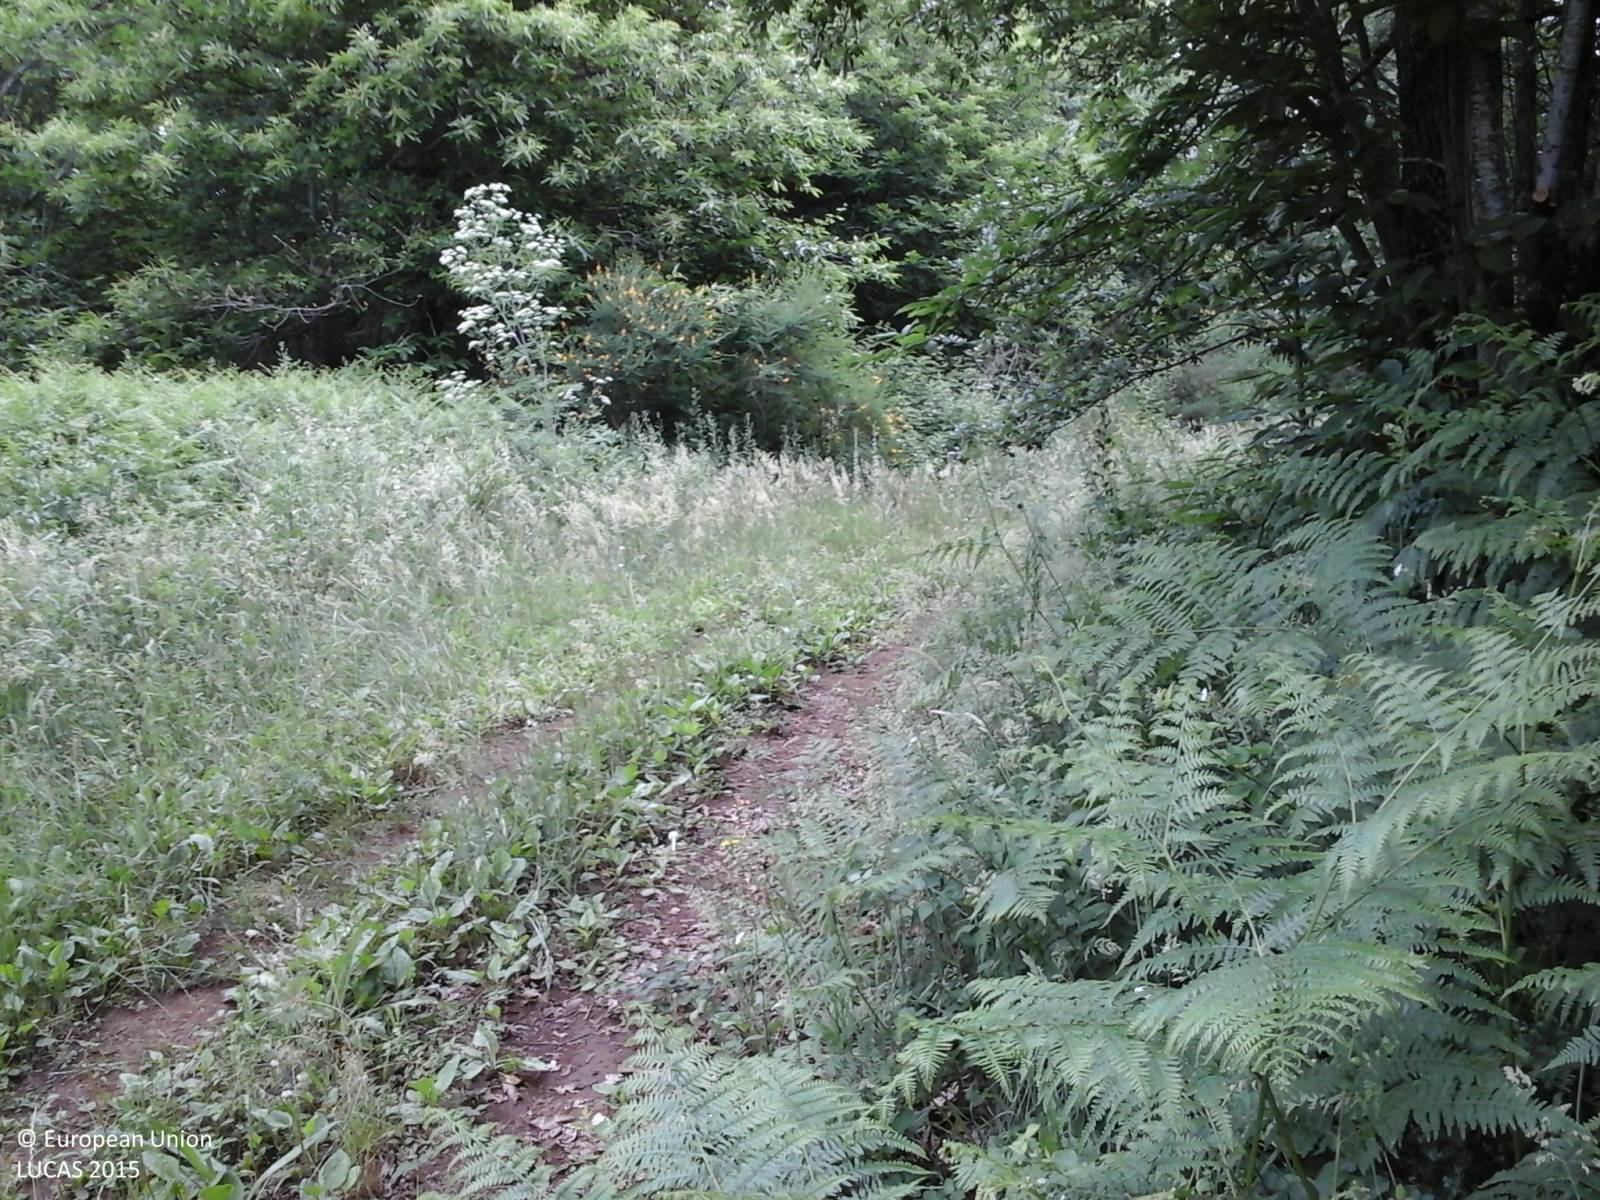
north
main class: Woodland
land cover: Broadleaved woodland
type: thermophilous deciduous forest
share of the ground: > 75 %
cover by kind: broadleaved forest trees 80 %, coniferous forest trees 20 %
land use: Forestry
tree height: > 5 m
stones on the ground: 25 - 50 %
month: June
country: IT
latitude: 42.3960
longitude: 12.1671
